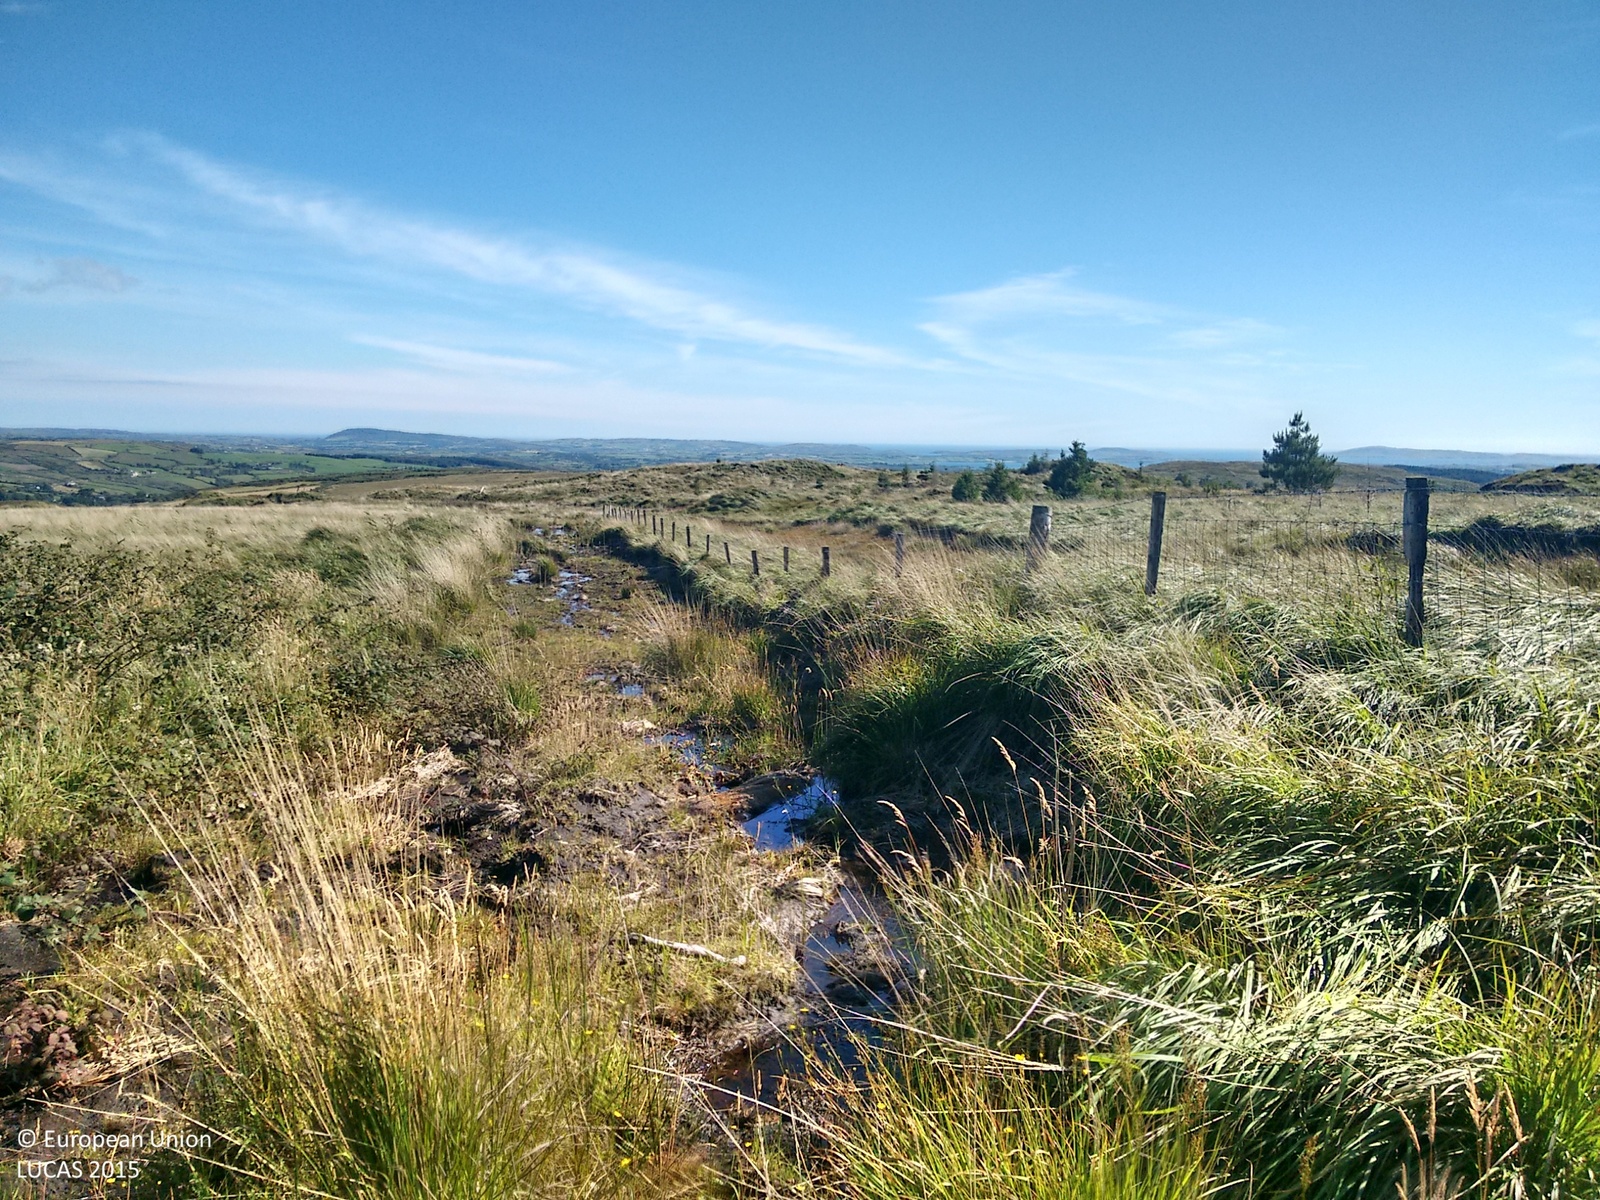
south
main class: Grassland
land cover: Spontaneously vegetated surfaces
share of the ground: > 75 %
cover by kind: herbaceous plants 70 %, unconsolidated bare surface 30 %
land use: Semi-natural and natural areas not in use
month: August
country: IE
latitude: 51.6199
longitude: -9.4251
